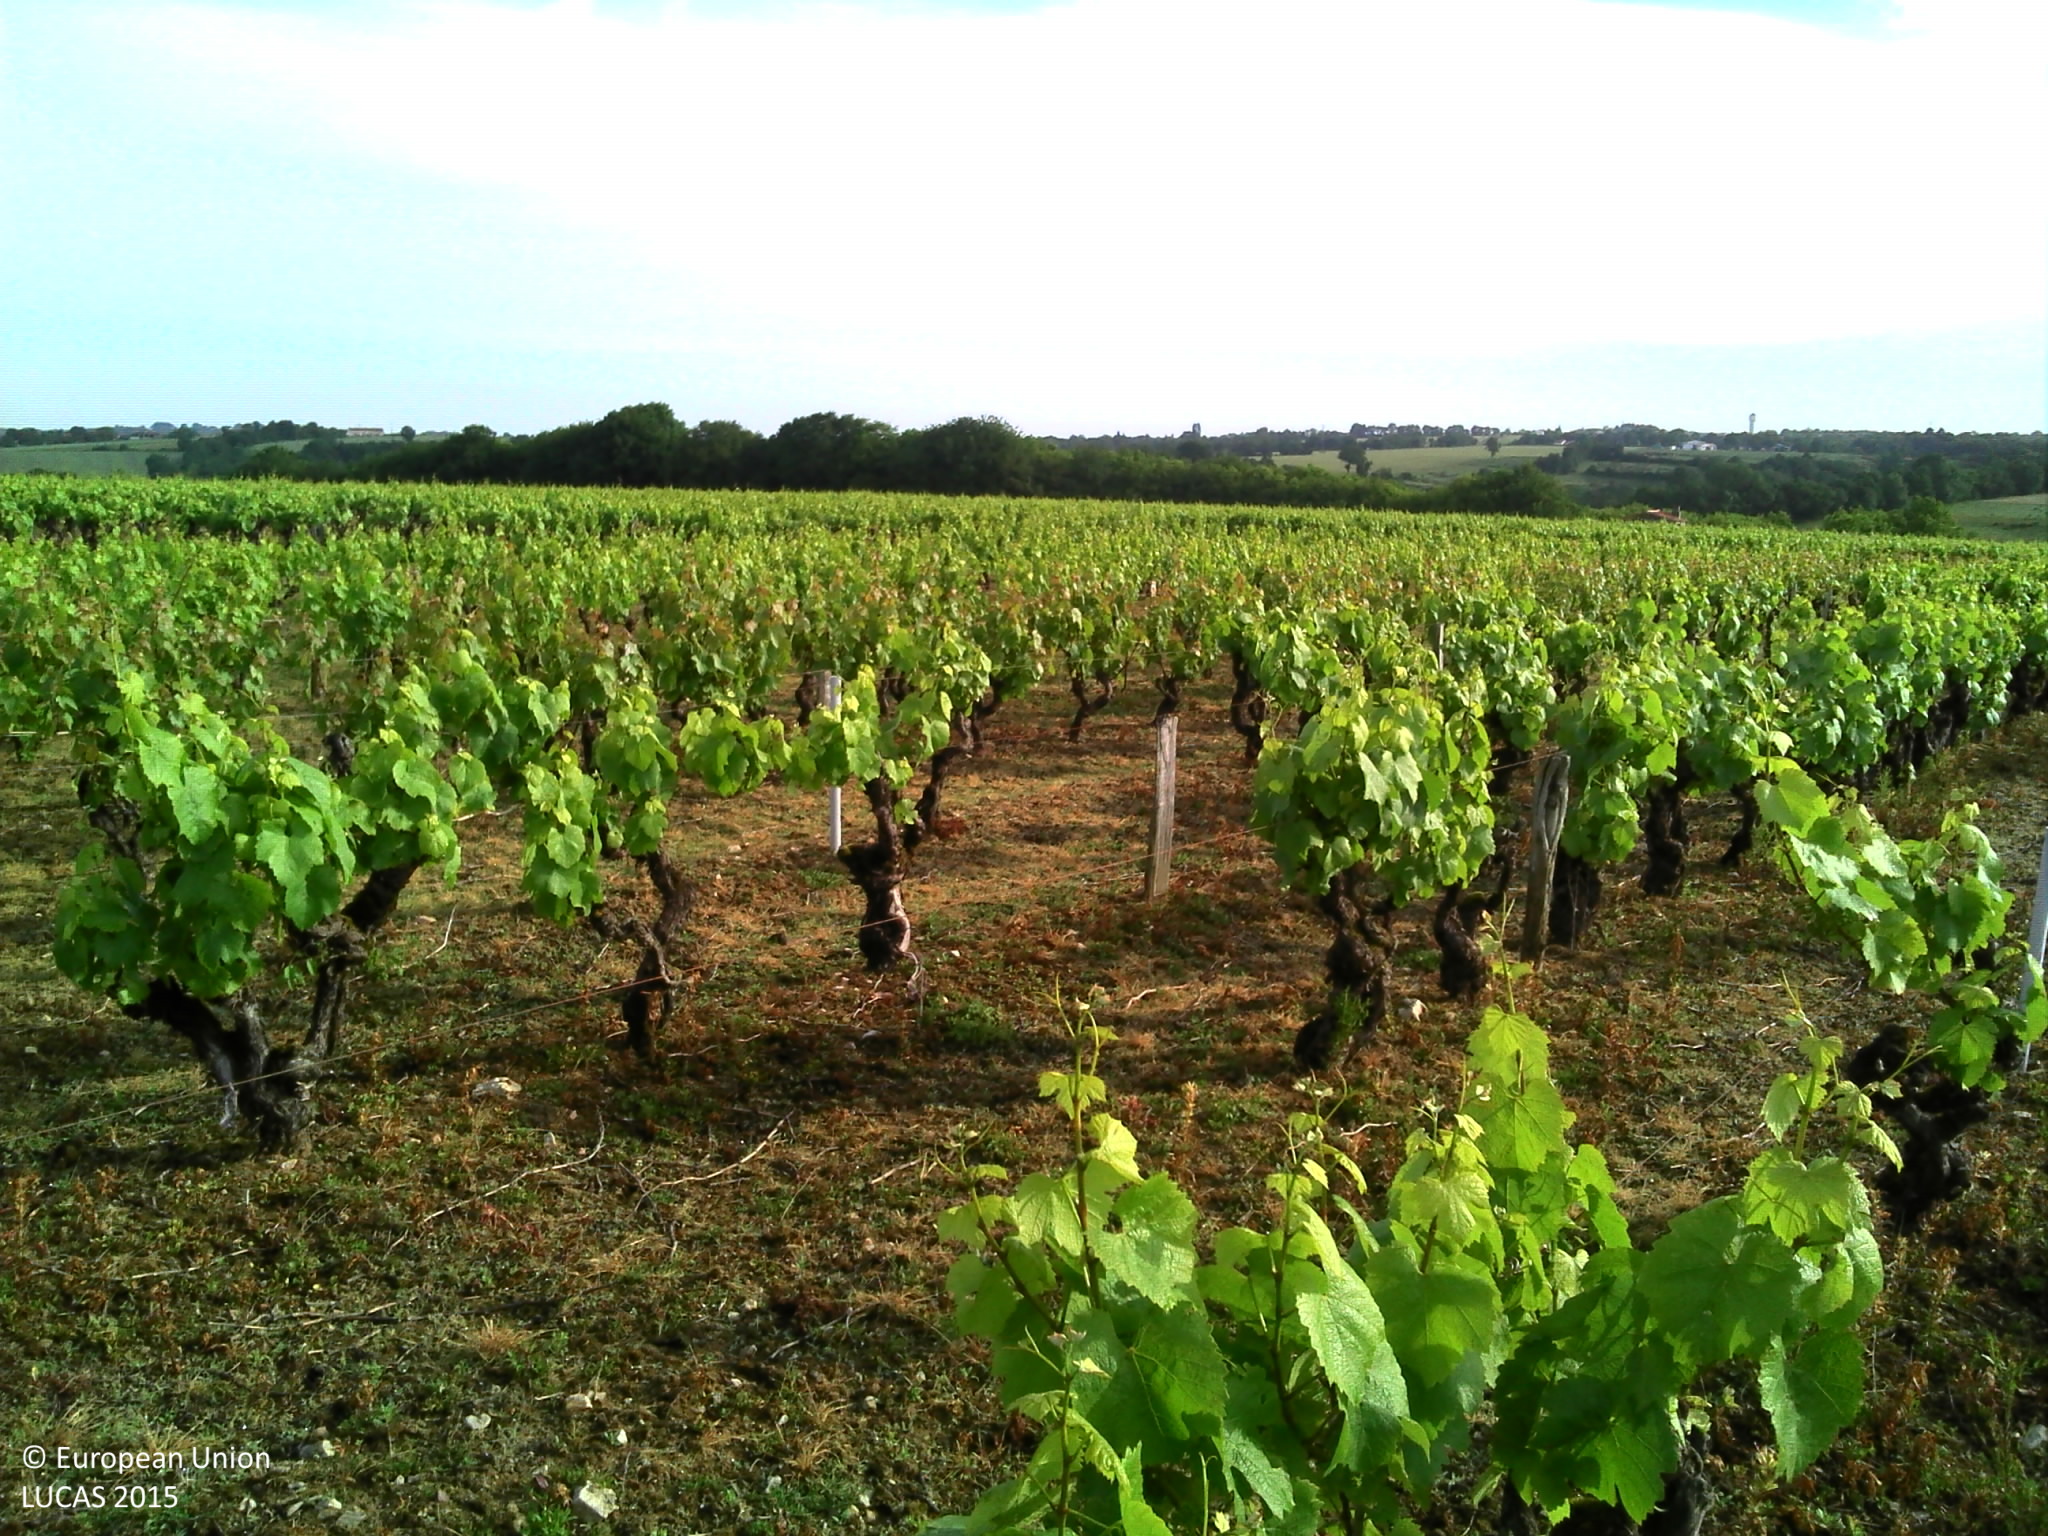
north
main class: Cropland
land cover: Vineyards
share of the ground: > 75 %
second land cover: Spontaneously vegetated surfaces
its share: 25 - 50 %
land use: Agriculture (excluding fallow land and kitchen gardens)
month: June
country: FR
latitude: 47.2960
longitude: -1.2930
